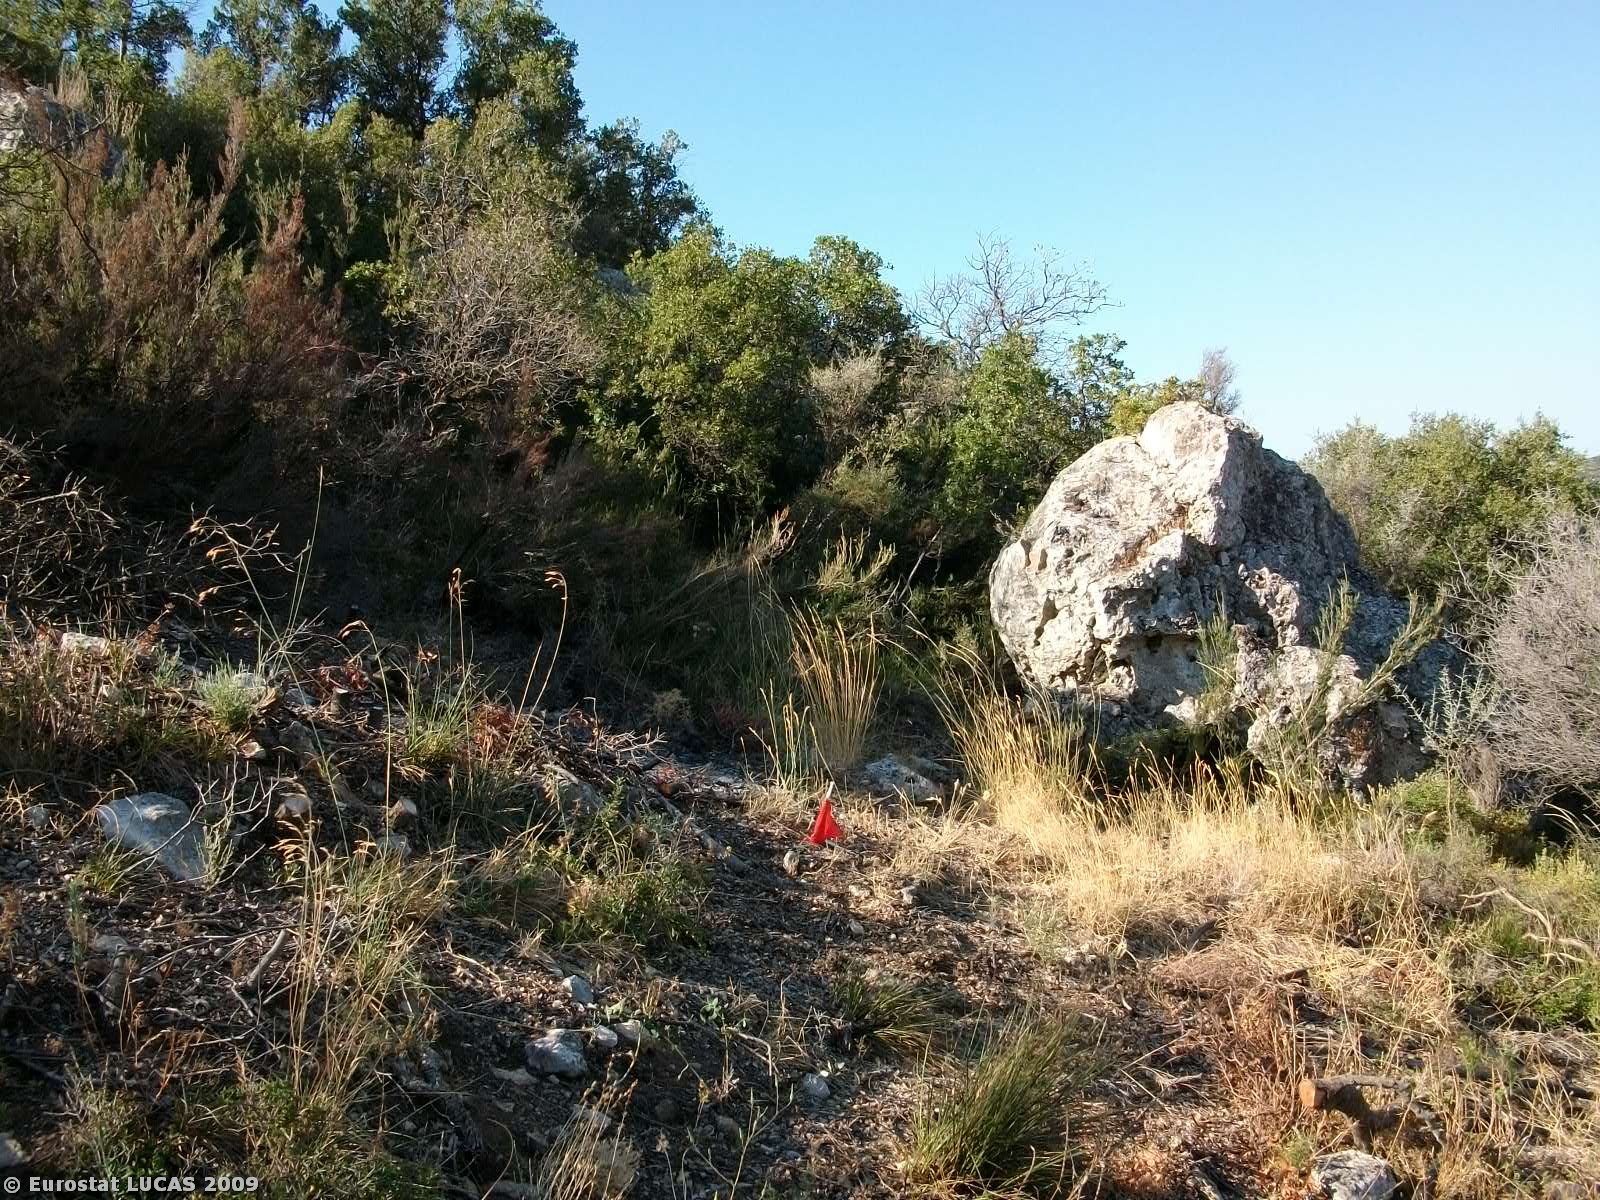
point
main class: Shrubland
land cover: Shrubland with sparse tree cover
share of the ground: > 75 %
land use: Unused
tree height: < 5 m
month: July
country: GR
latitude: 37.6294
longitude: 22.9419
